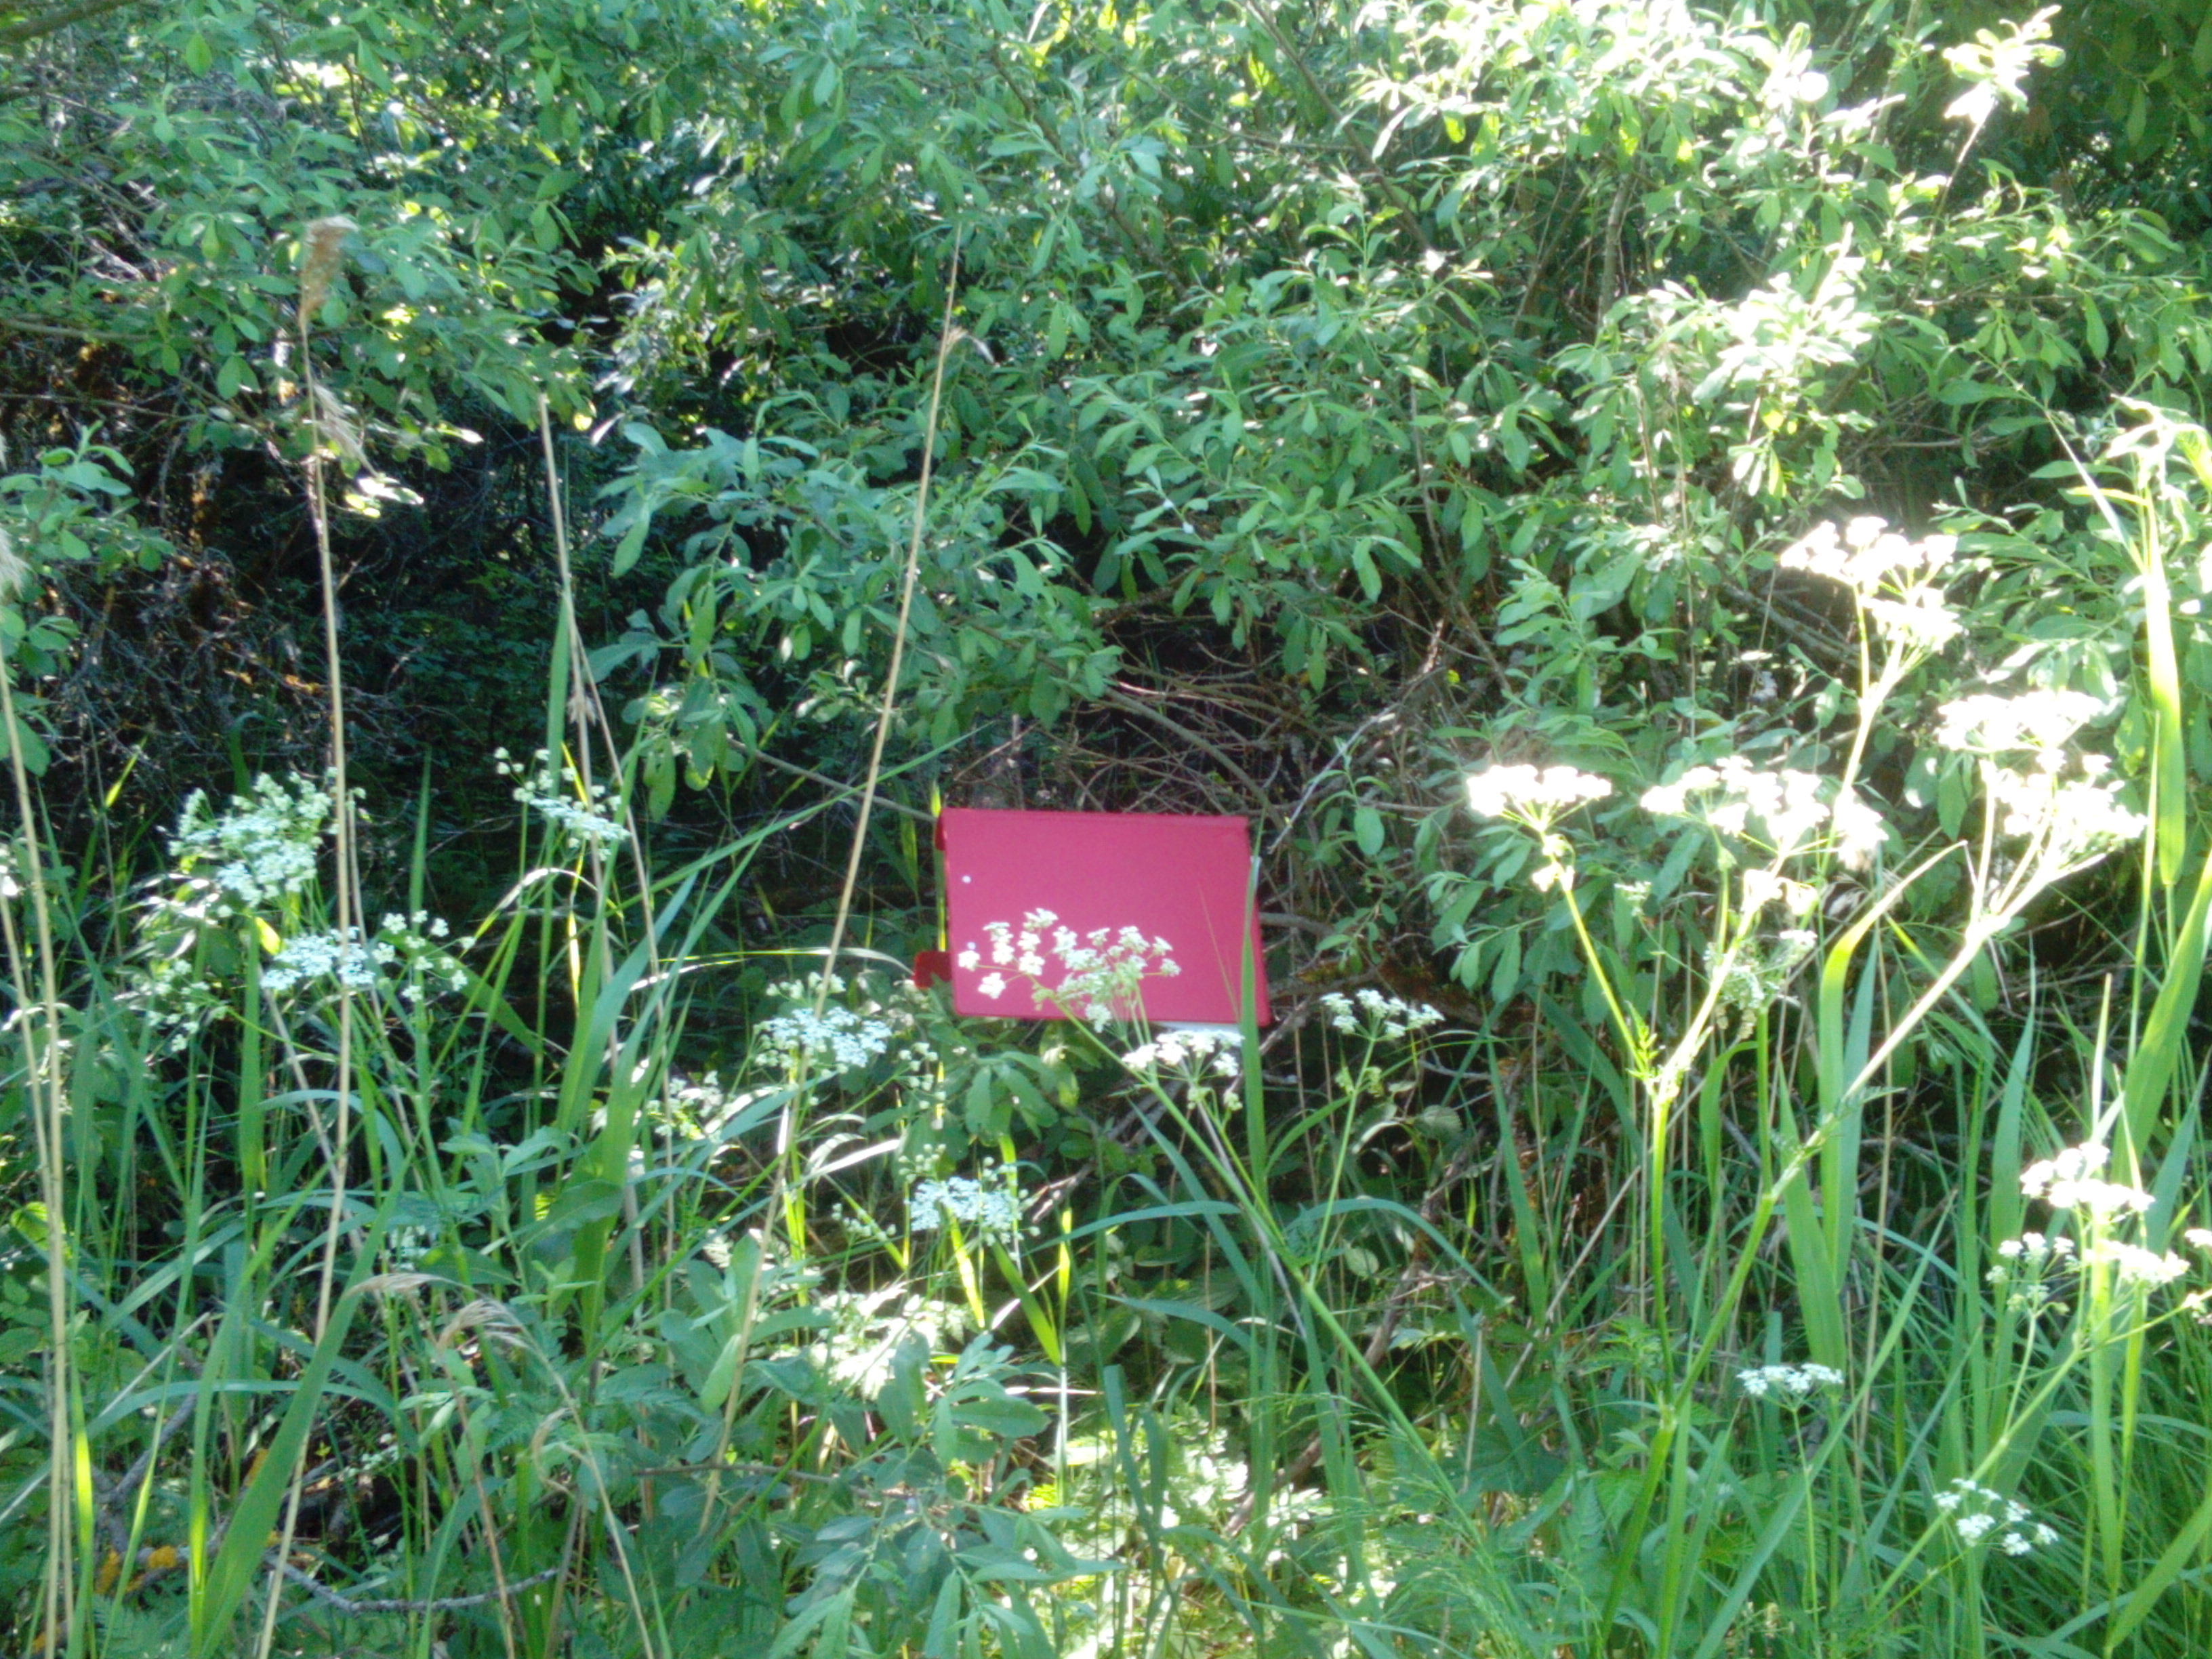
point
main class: Woodland
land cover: Broadleaved woodland
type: non-riverine alder, birch or aspen forest
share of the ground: > 75 %
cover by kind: broadleaved forest trees 65 %, coniferous forest trees 20 %, shrubs 10 %, herbaceous plants 5 %
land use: Forestry
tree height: > 5 m
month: June
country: LV
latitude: 56.5849
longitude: 22.2148
